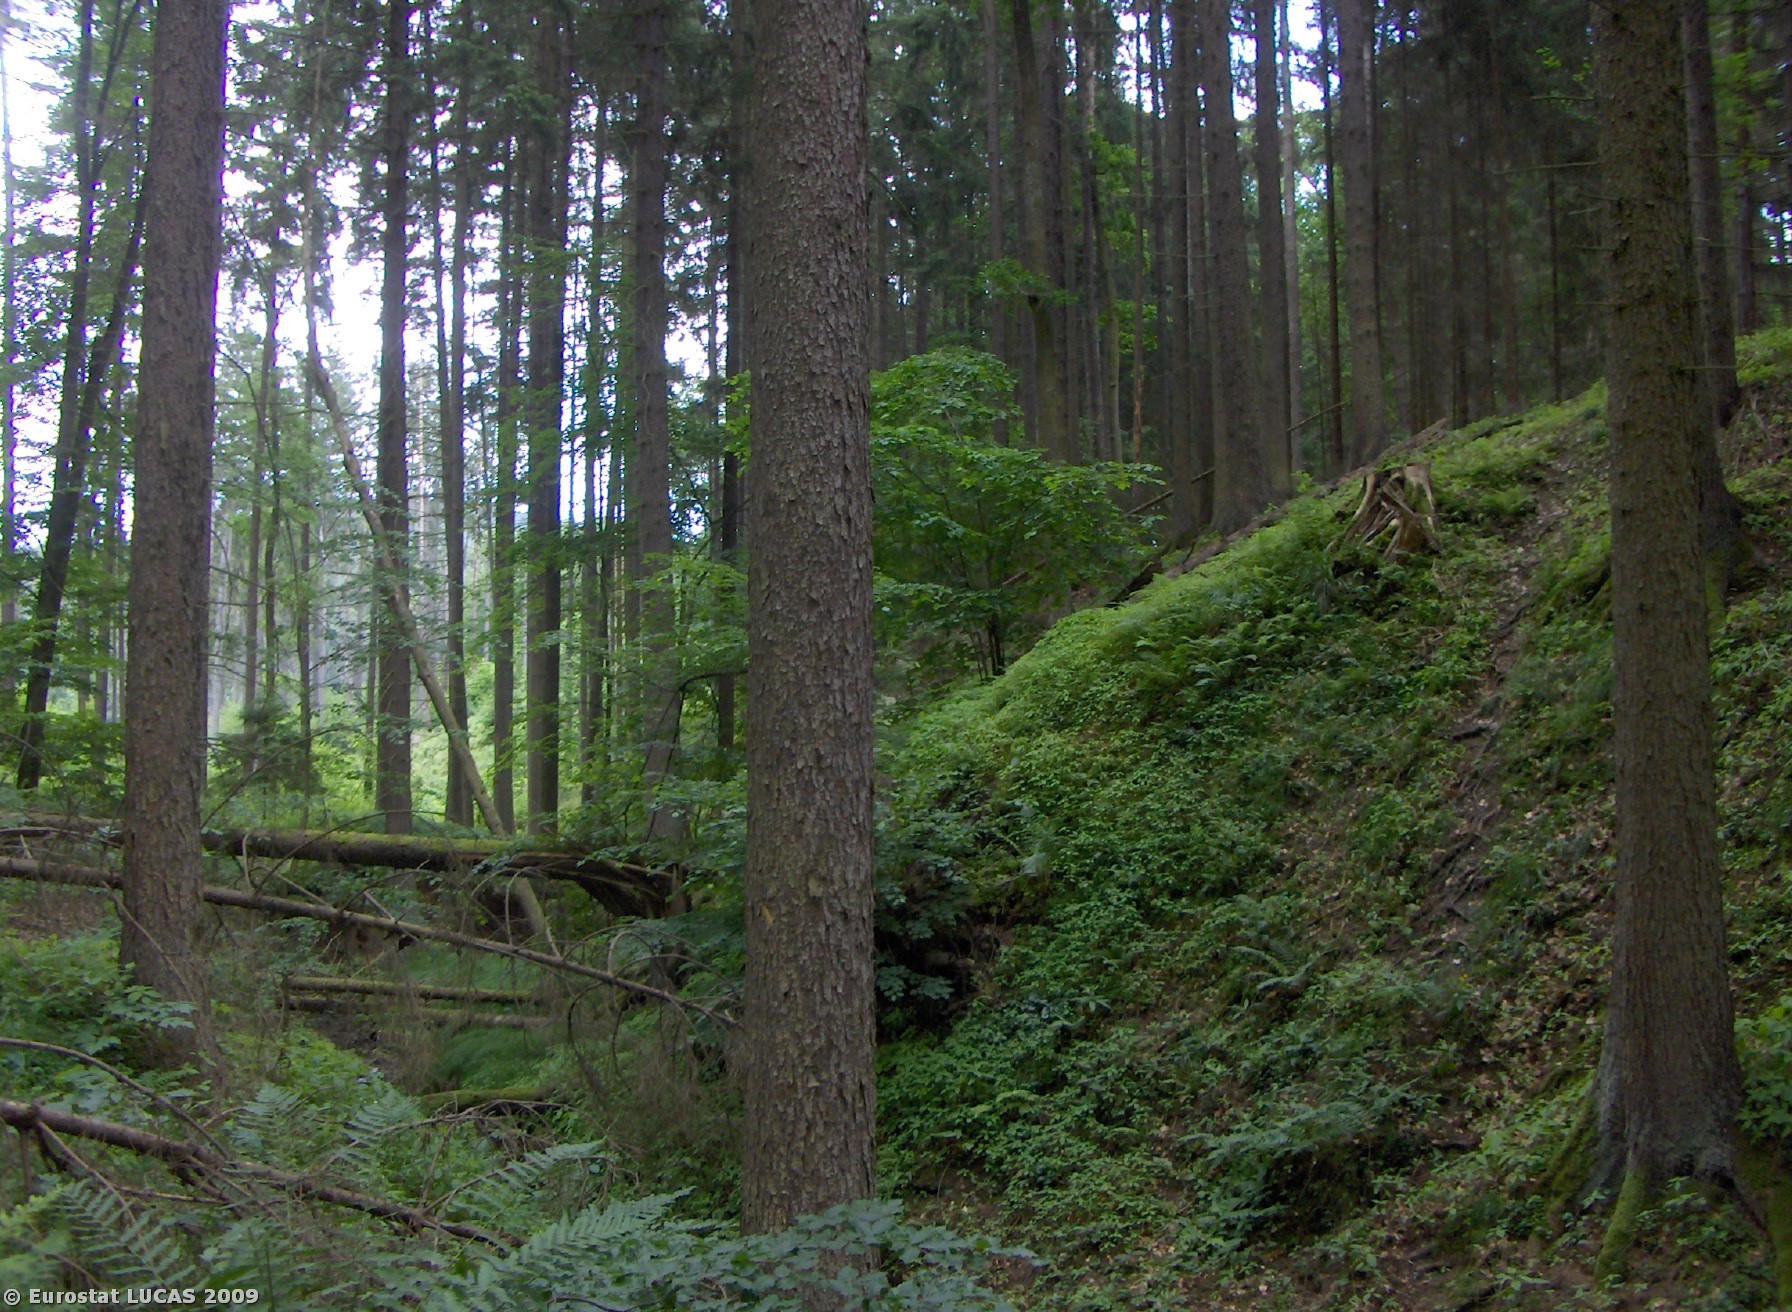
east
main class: Woodland
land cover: Coniferous woodland
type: hemiboreal forest and nemoral coniferous forest and mixed broadleaved-coniferous forest
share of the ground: > 75 %
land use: Forestry
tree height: > 5 m
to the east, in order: Coniferous woodland; Rivers and streams; Coniferous woodland; Tracks; Coniferous woodland; Mixed woodland; Inland running water
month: June
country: CZ
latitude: 49.2915
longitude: 14.3322
